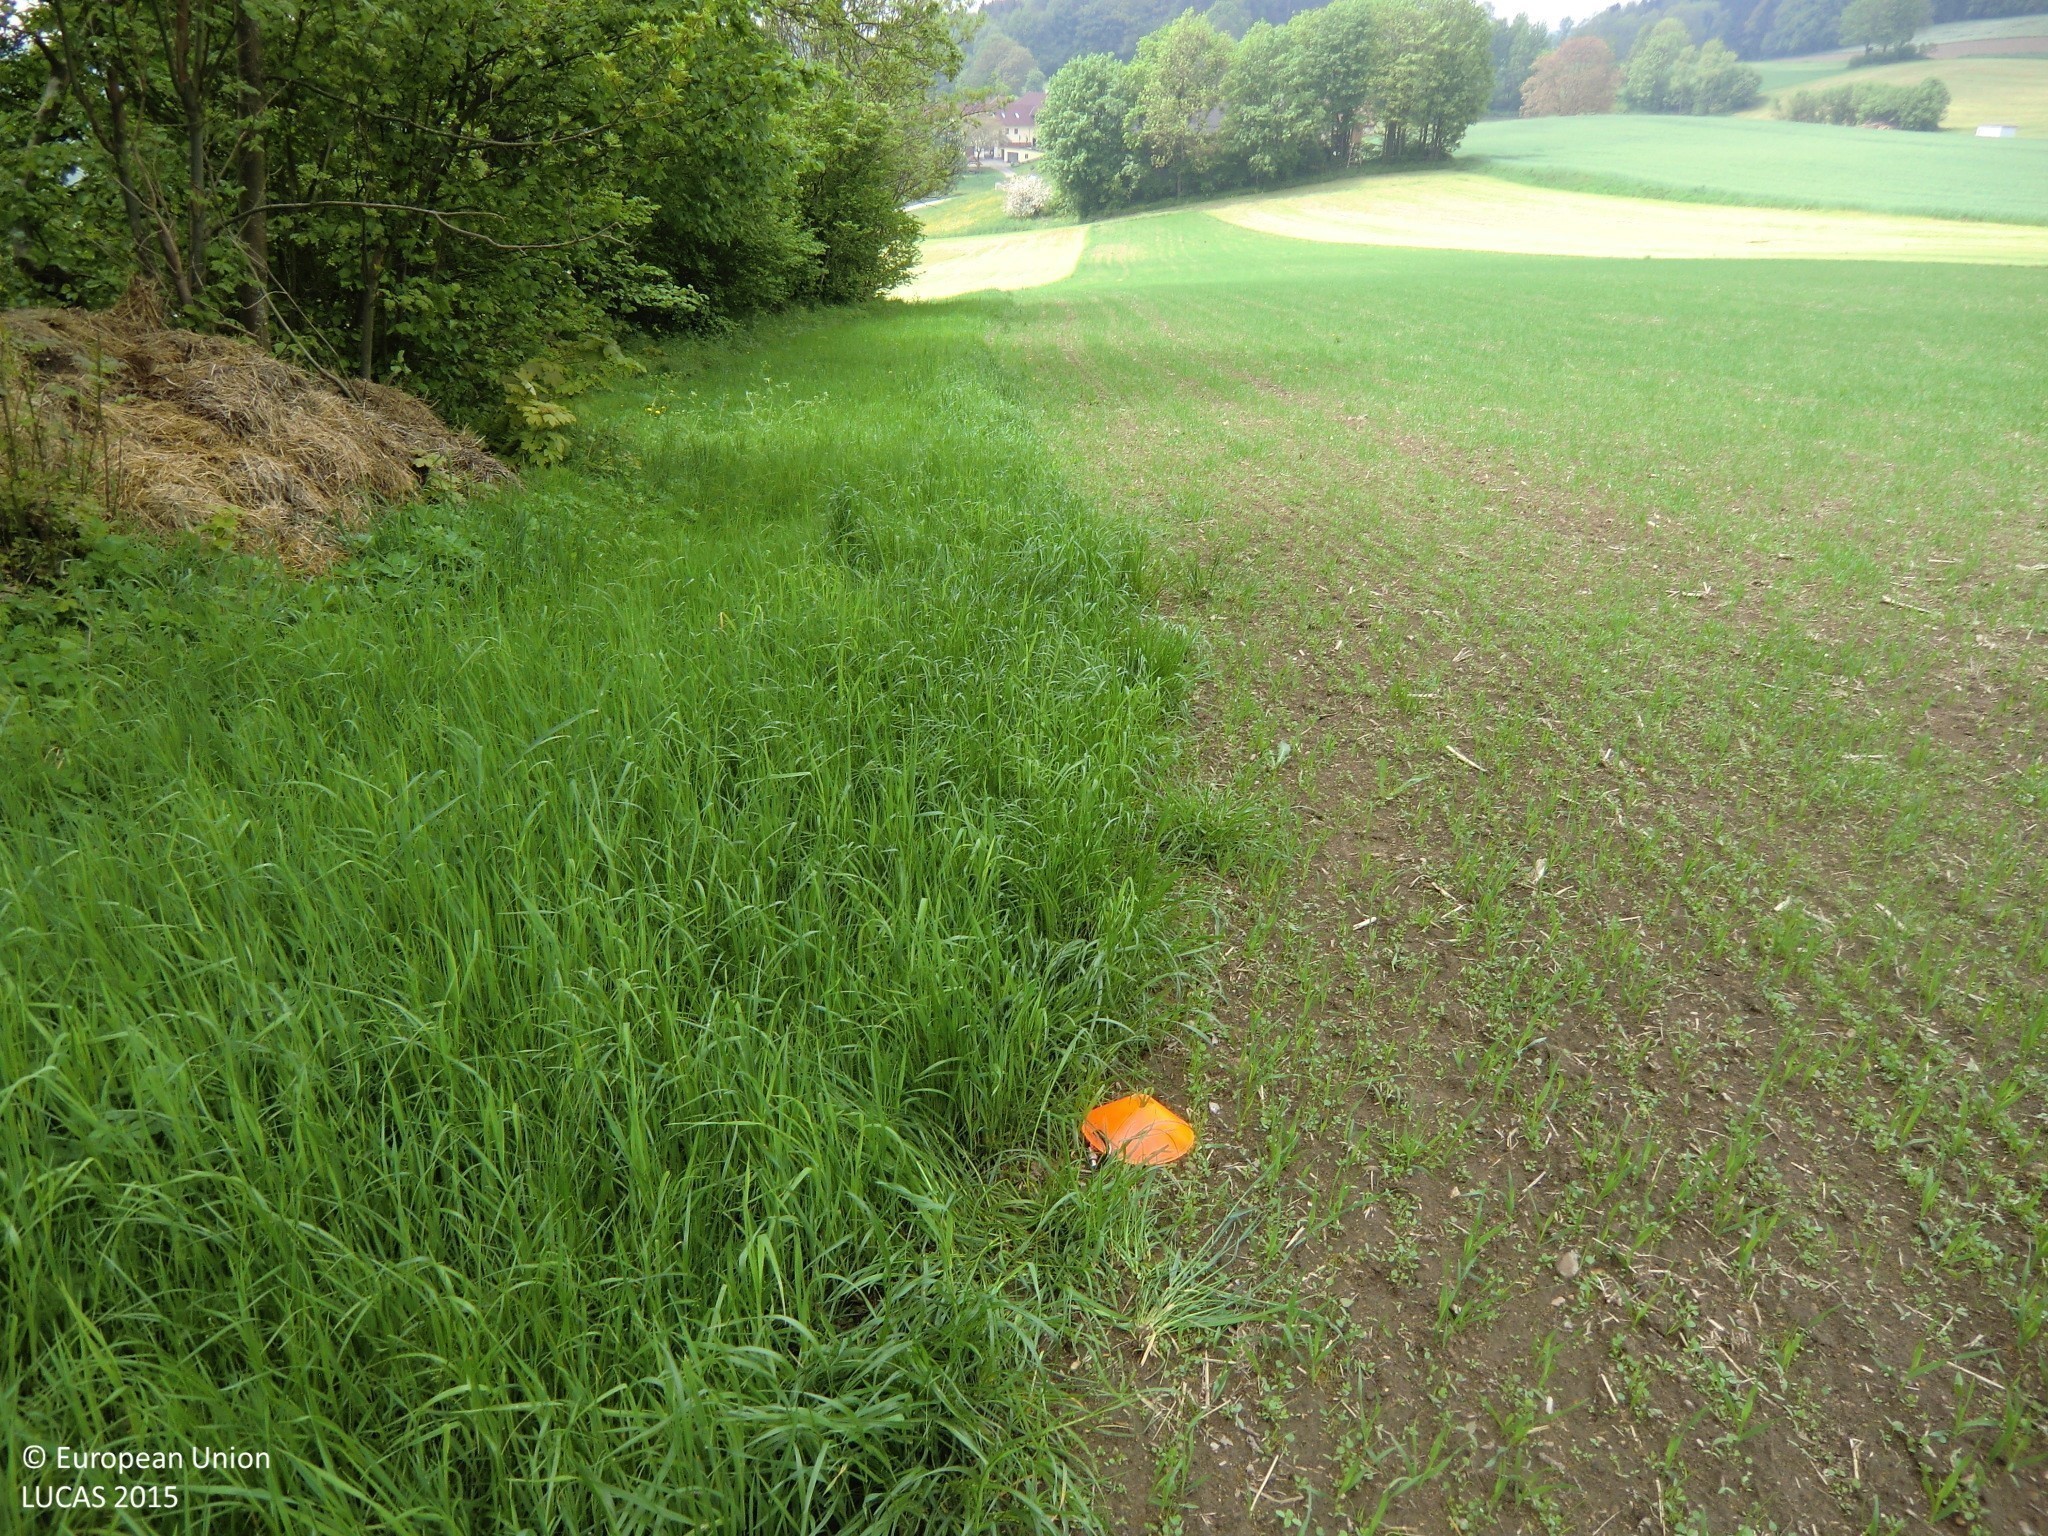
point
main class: Cropland
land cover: Clovers
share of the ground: 25 - 50 %
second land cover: Rye
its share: 25 - 50 %
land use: Agriculture (excluding fallow land and kitchen gardens)
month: May
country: AT
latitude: 48.3895
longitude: 14.3623
